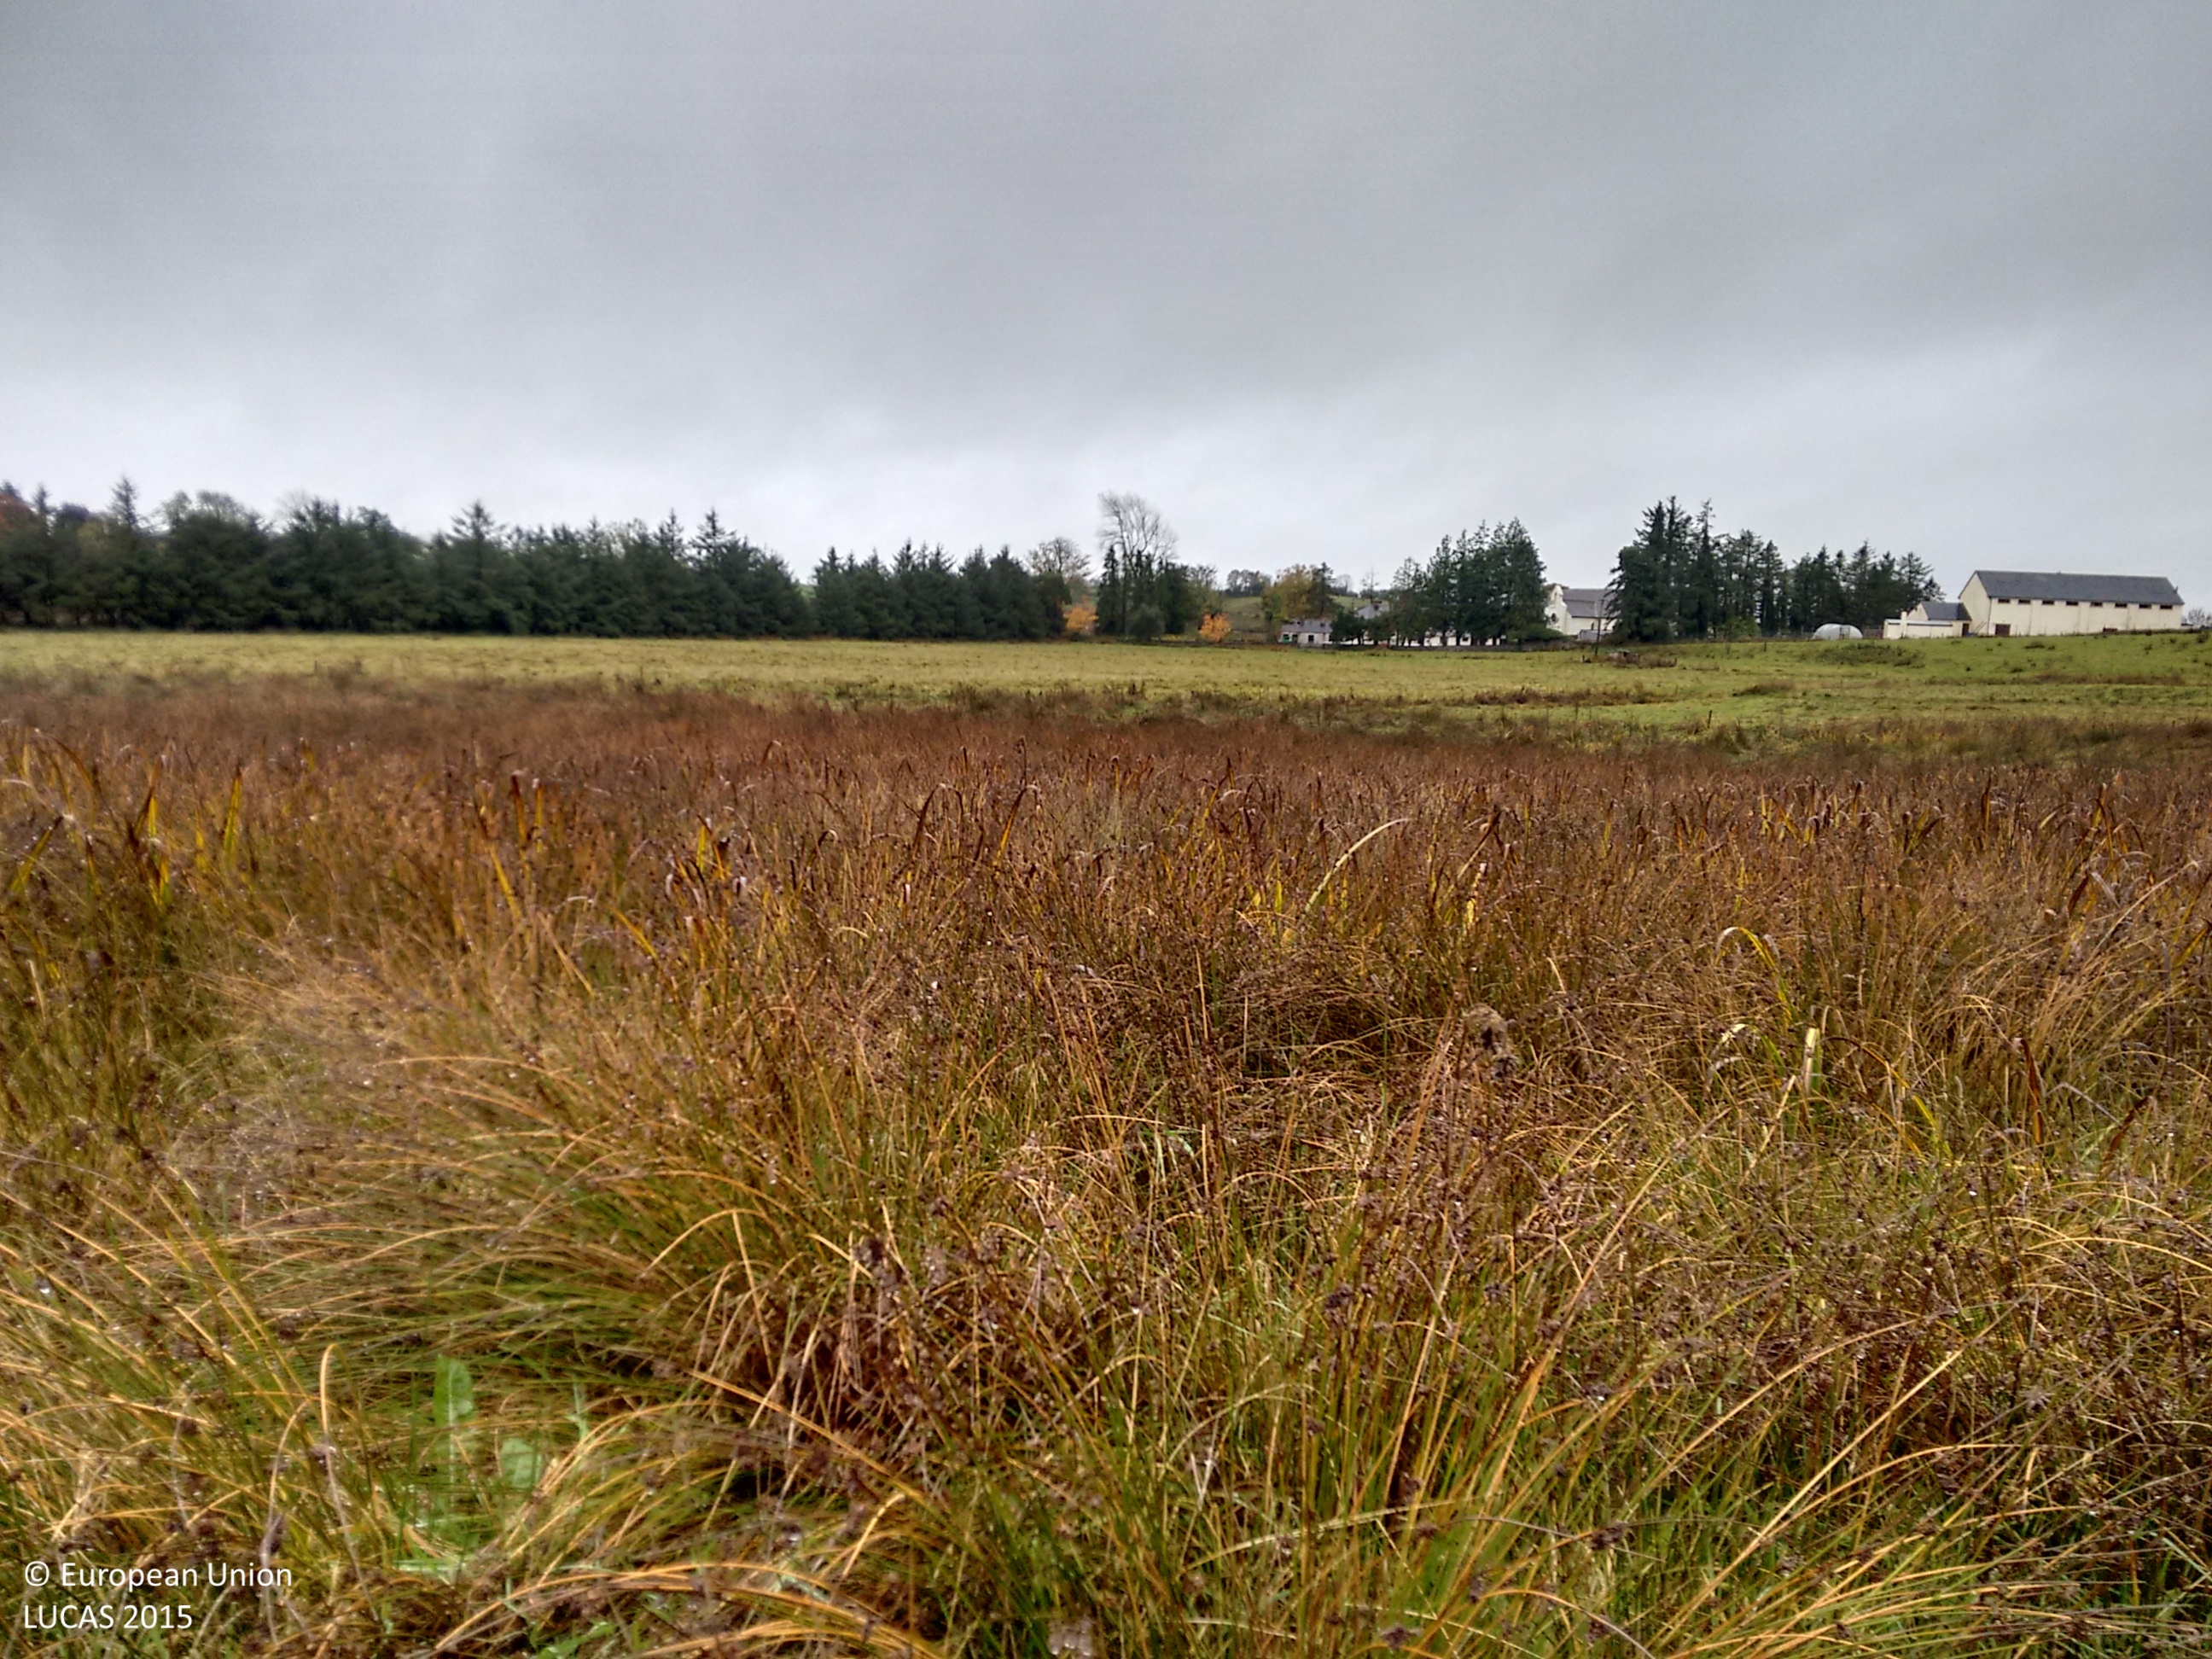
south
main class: Grassland
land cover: Grassland without tree/shrub cover
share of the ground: > 75 %
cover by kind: herbaceous plants 100 %
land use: Agriculture (excluding fallow land and kitchen gardens)
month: October
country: IE
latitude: 53.8967
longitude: -8.0260
